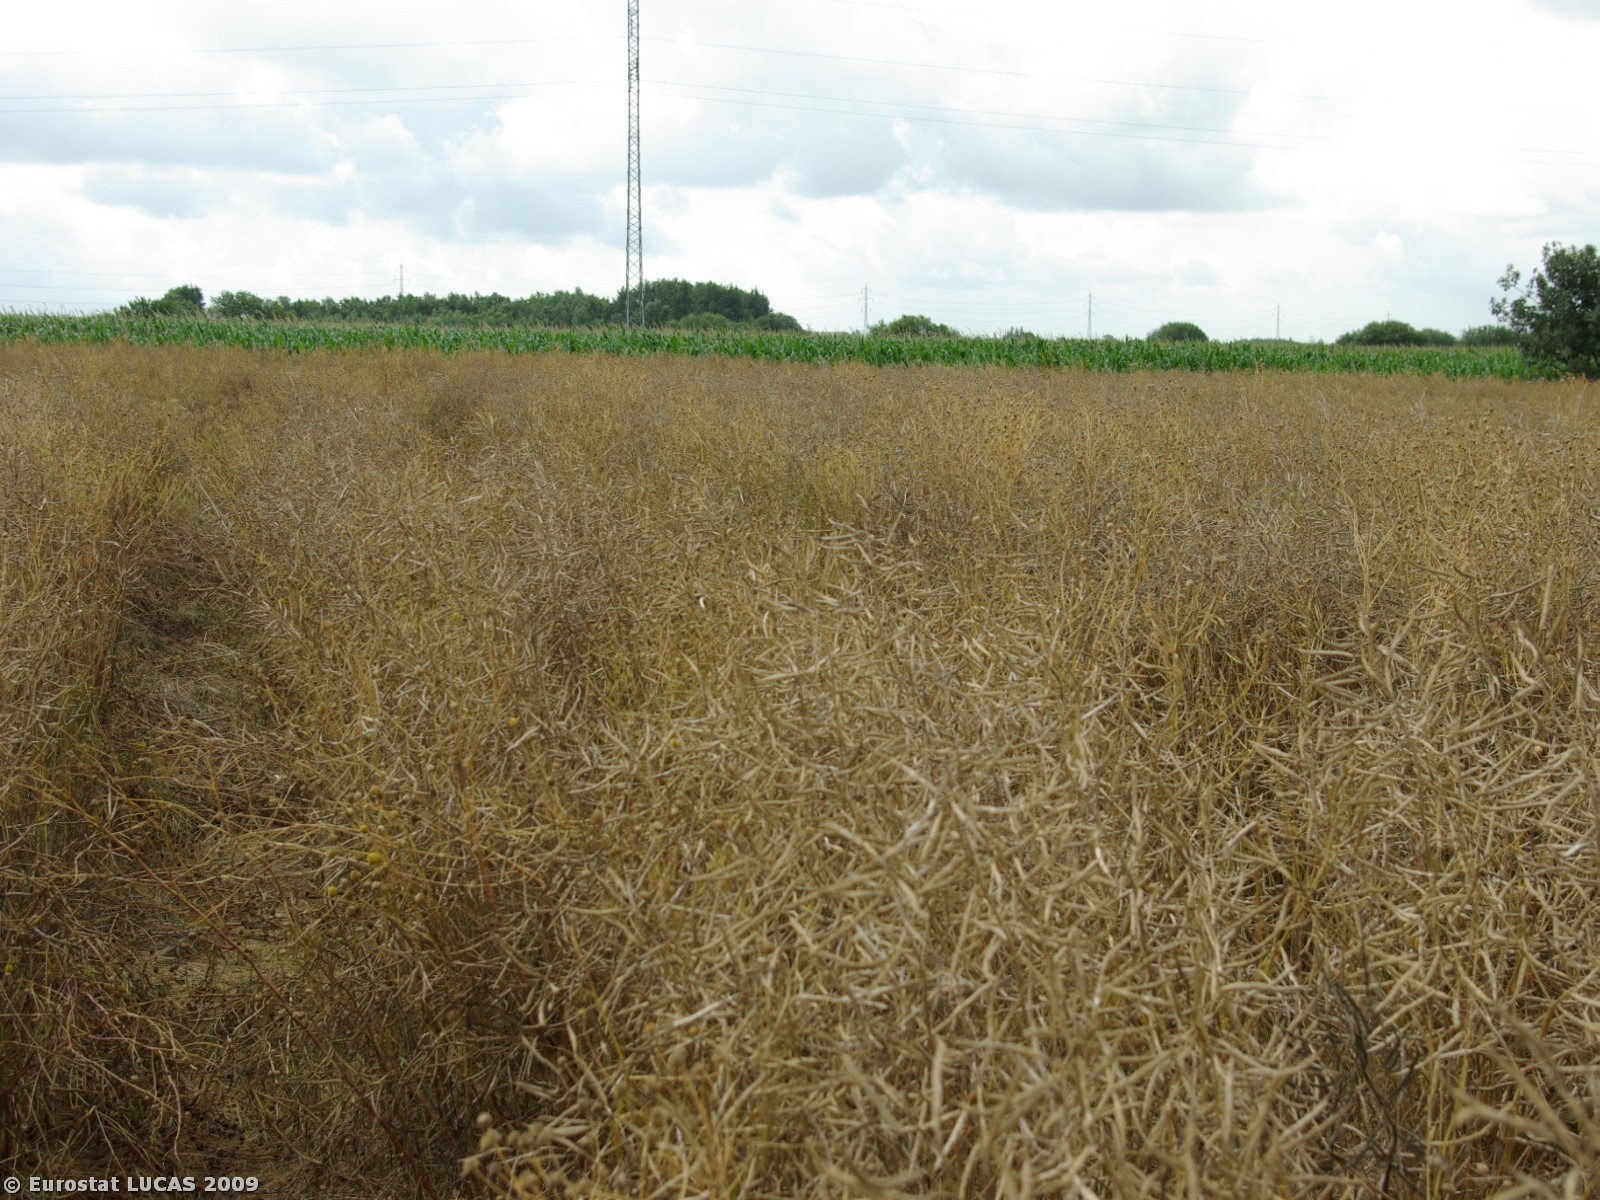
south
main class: Cropland
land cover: Rape and turnip rape
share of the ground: > 75 %
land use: Agriculture (excluding fallow land and kitchen gardens)
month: July
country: DK
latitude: 54.9606
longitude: 8.8920
